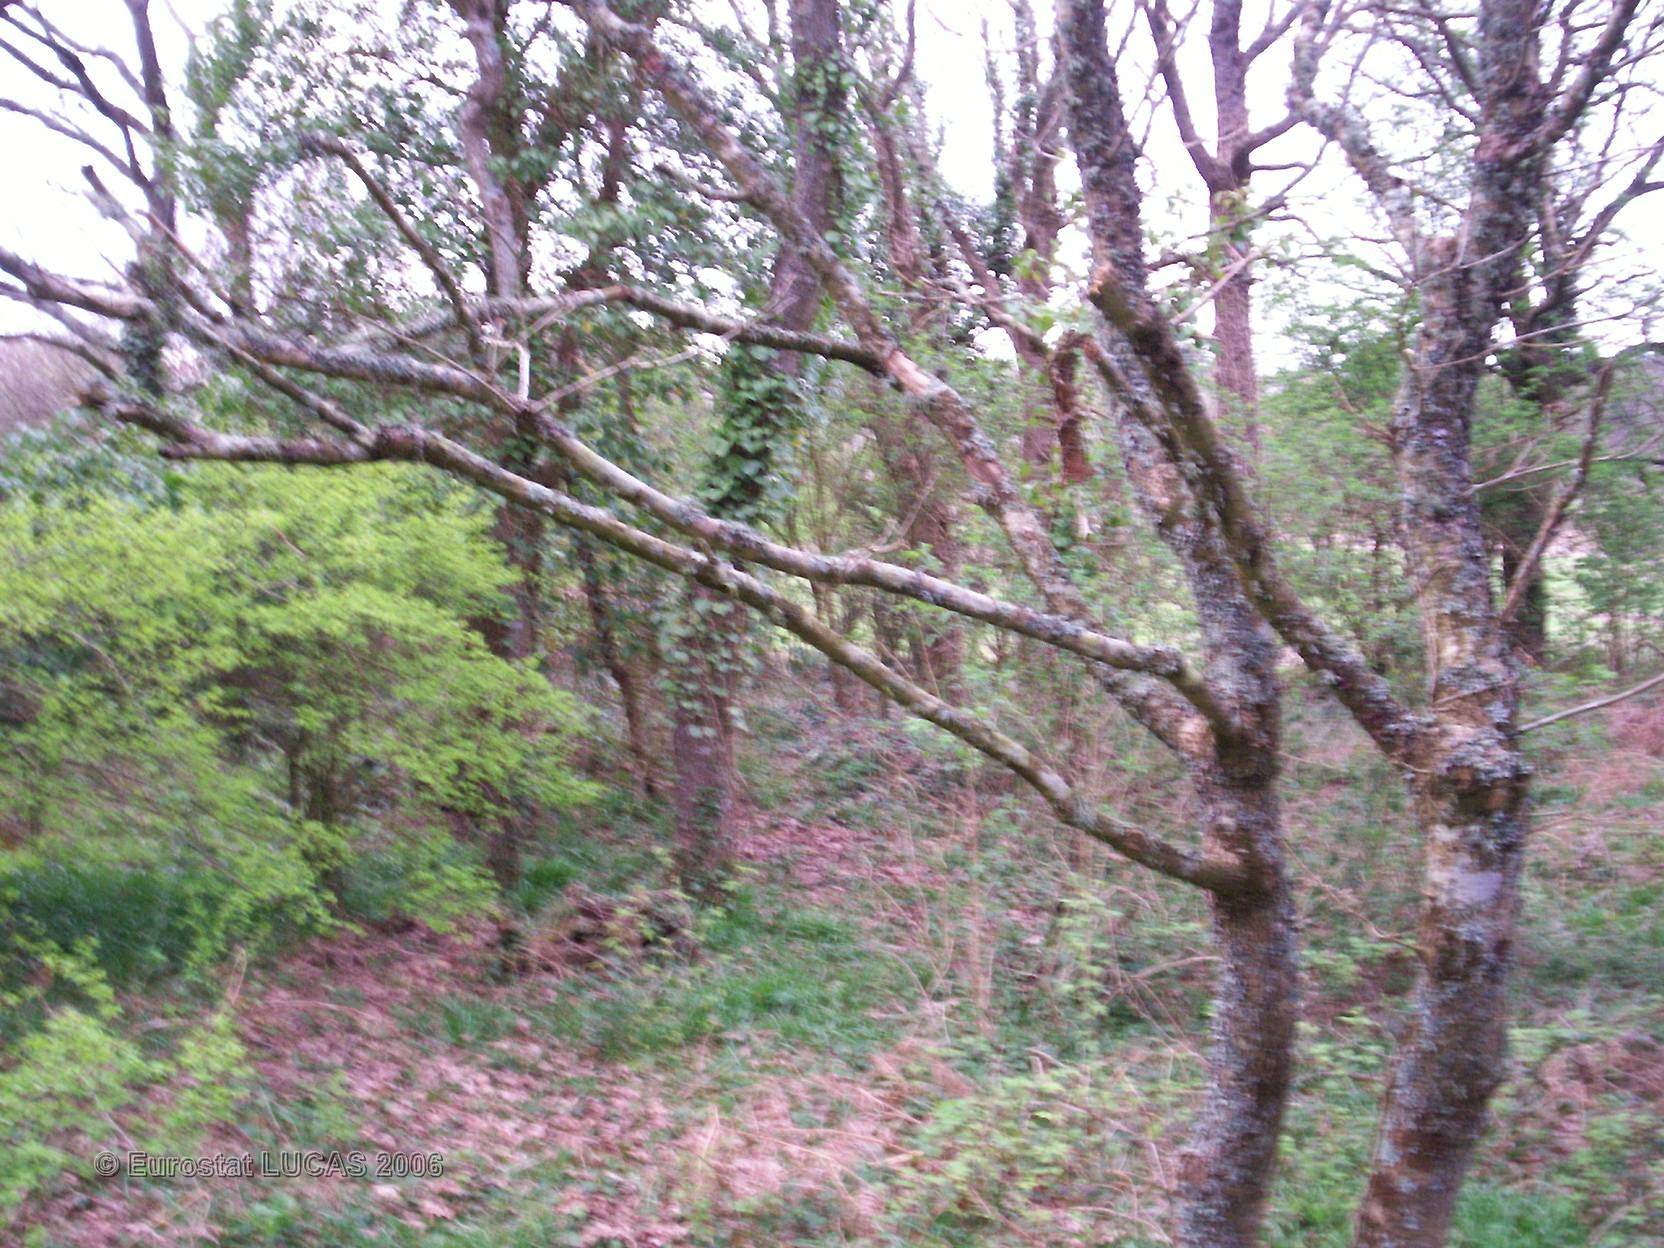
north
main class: Woodland
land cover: Broadleaved forest
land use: Forestry
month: April
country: FR
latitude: 47.7942
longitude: -3.4646
